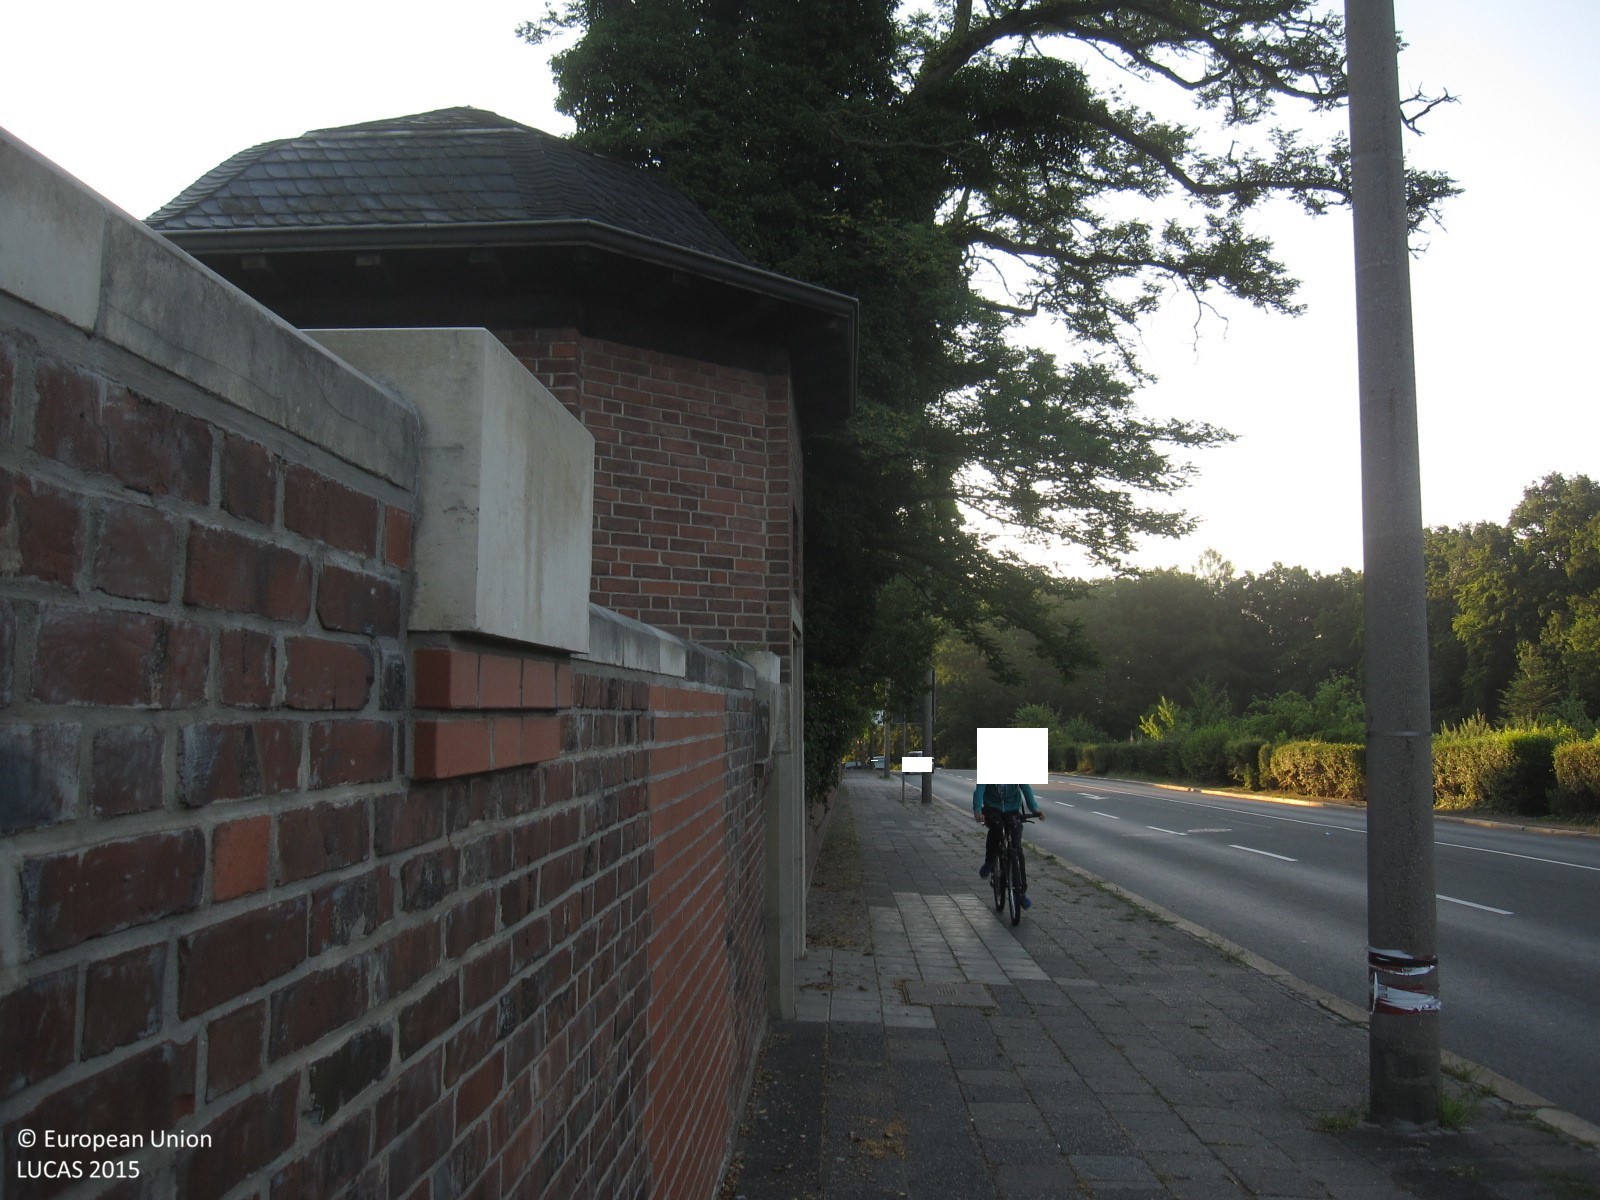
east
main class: Grassland
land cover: Grassland with sparse tree/shrub cover
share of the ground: > 75 %
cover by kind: herbaceous plants 95 %, broadleaved forest trees 5 %
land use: Residential
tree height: > 5 m
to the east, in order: Grassland with sparse tree/shrub cover; Artificial constructions in urban areas
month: July
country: DE
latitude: 50.8671
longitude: 12.0600
